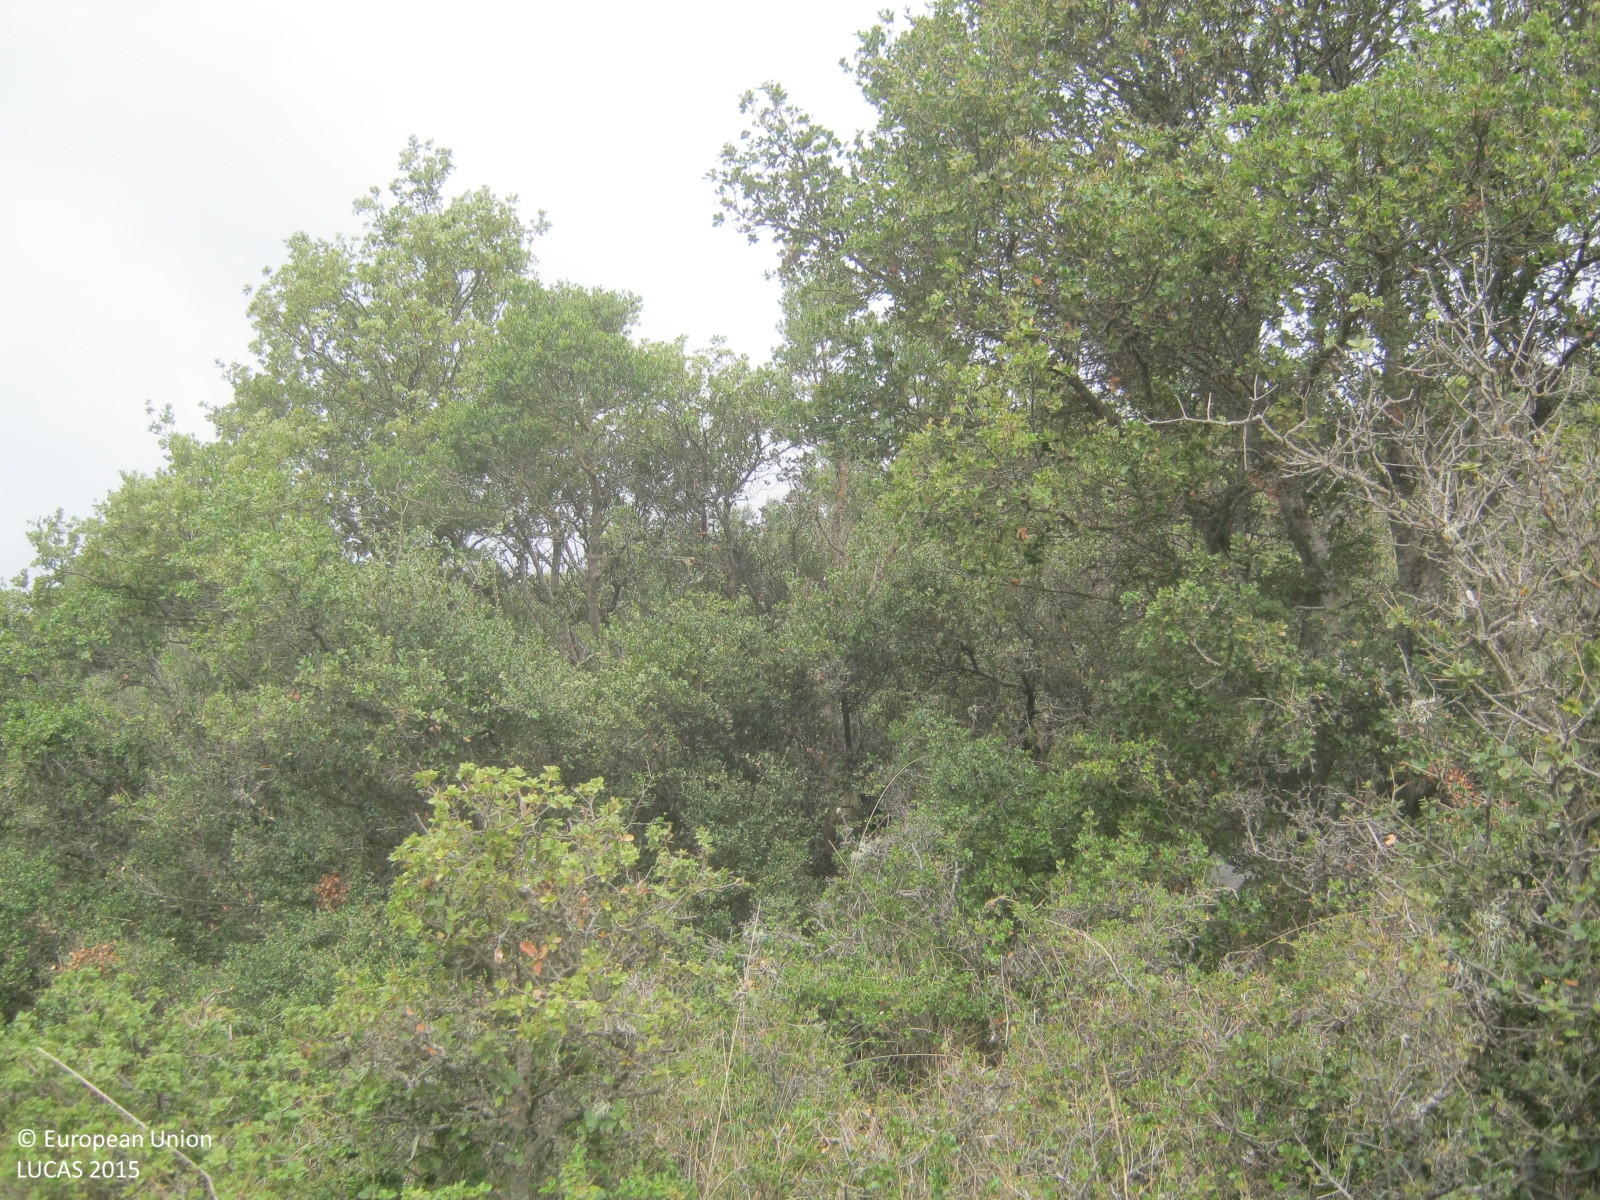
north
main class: Shrubland
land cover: Shrubland with sparse tree cover
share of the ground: 50 - 75 %
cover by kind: shrubs 60 %, unconsolidated bare surface 20 %, herbaceous plants 15 %, broadleaved forest trees 5 %
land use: Agriculture (excluding fallow land and kitchen gardens)
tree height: > 5 m
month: September
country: GR
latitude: 37.9086
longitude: 22.0784
